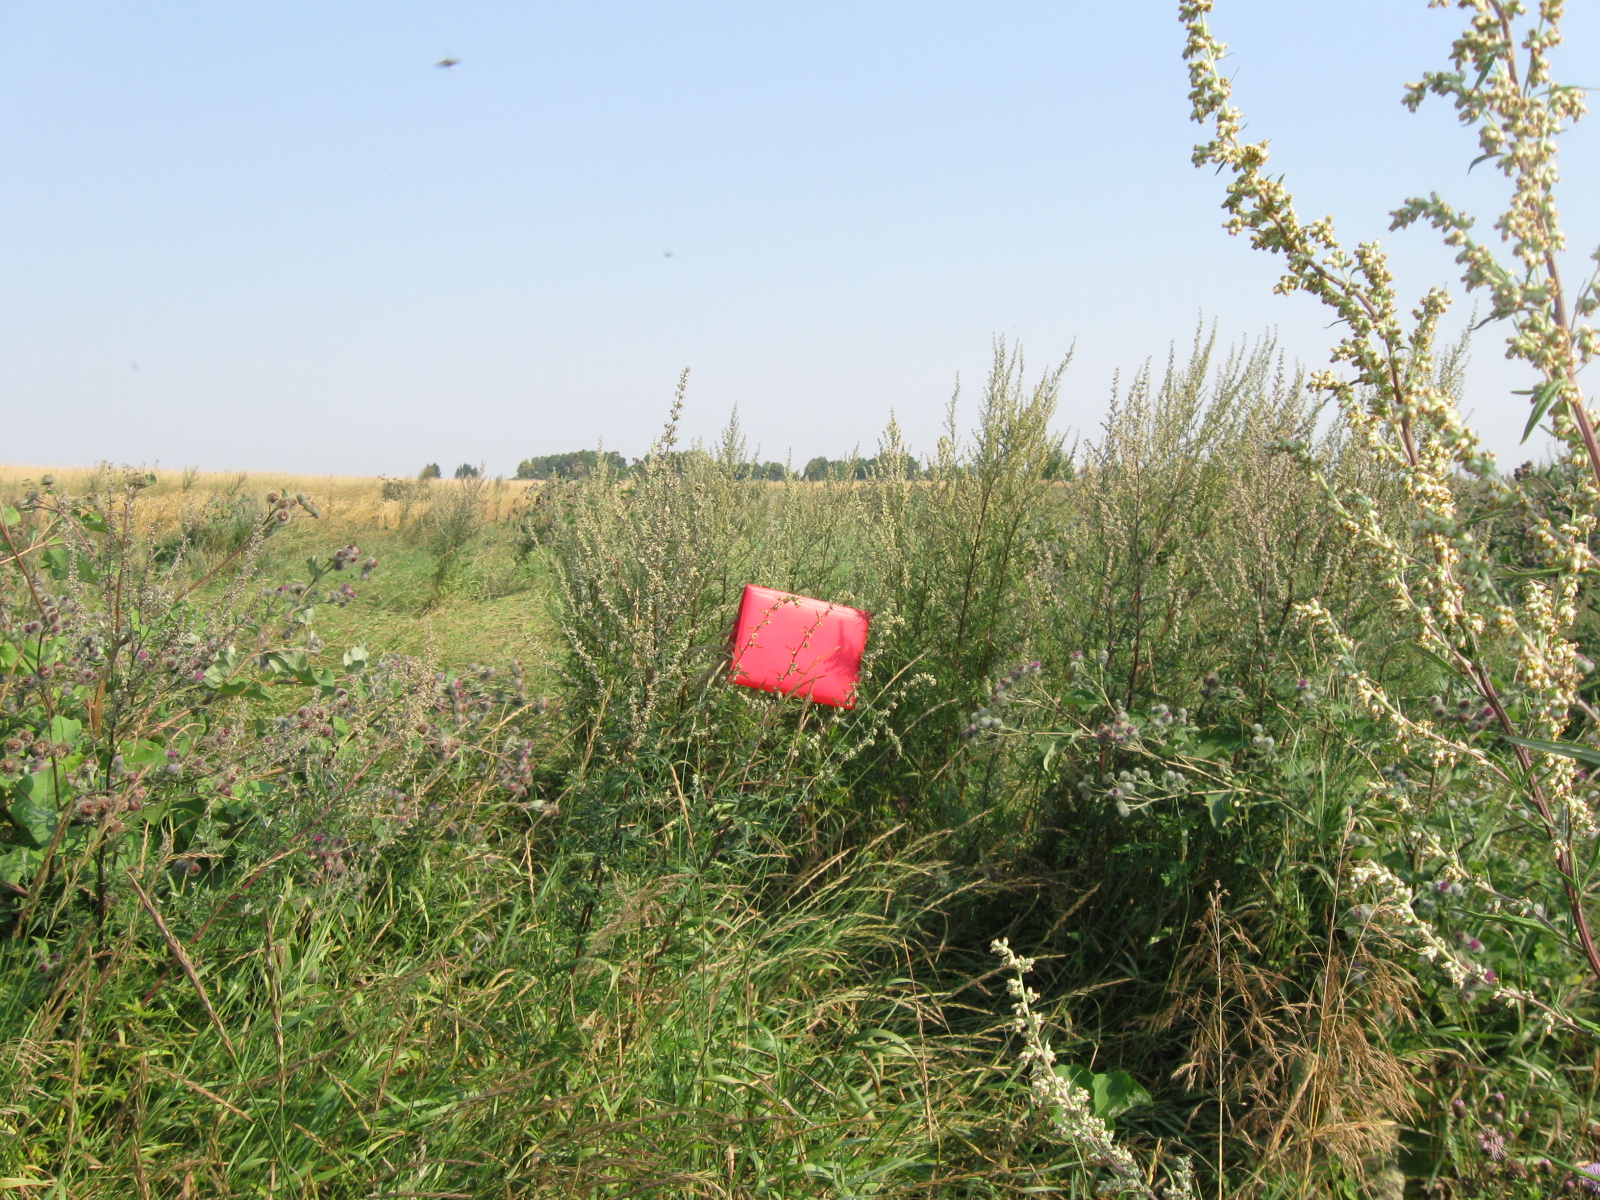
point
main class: Grassland
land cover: Spontaneously vegetated surfaces
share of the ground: > 75 %
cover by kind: herbaceous plants 100 %
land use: Fallow land
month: August
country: LT
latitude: 54.3493
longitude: 23.2311
